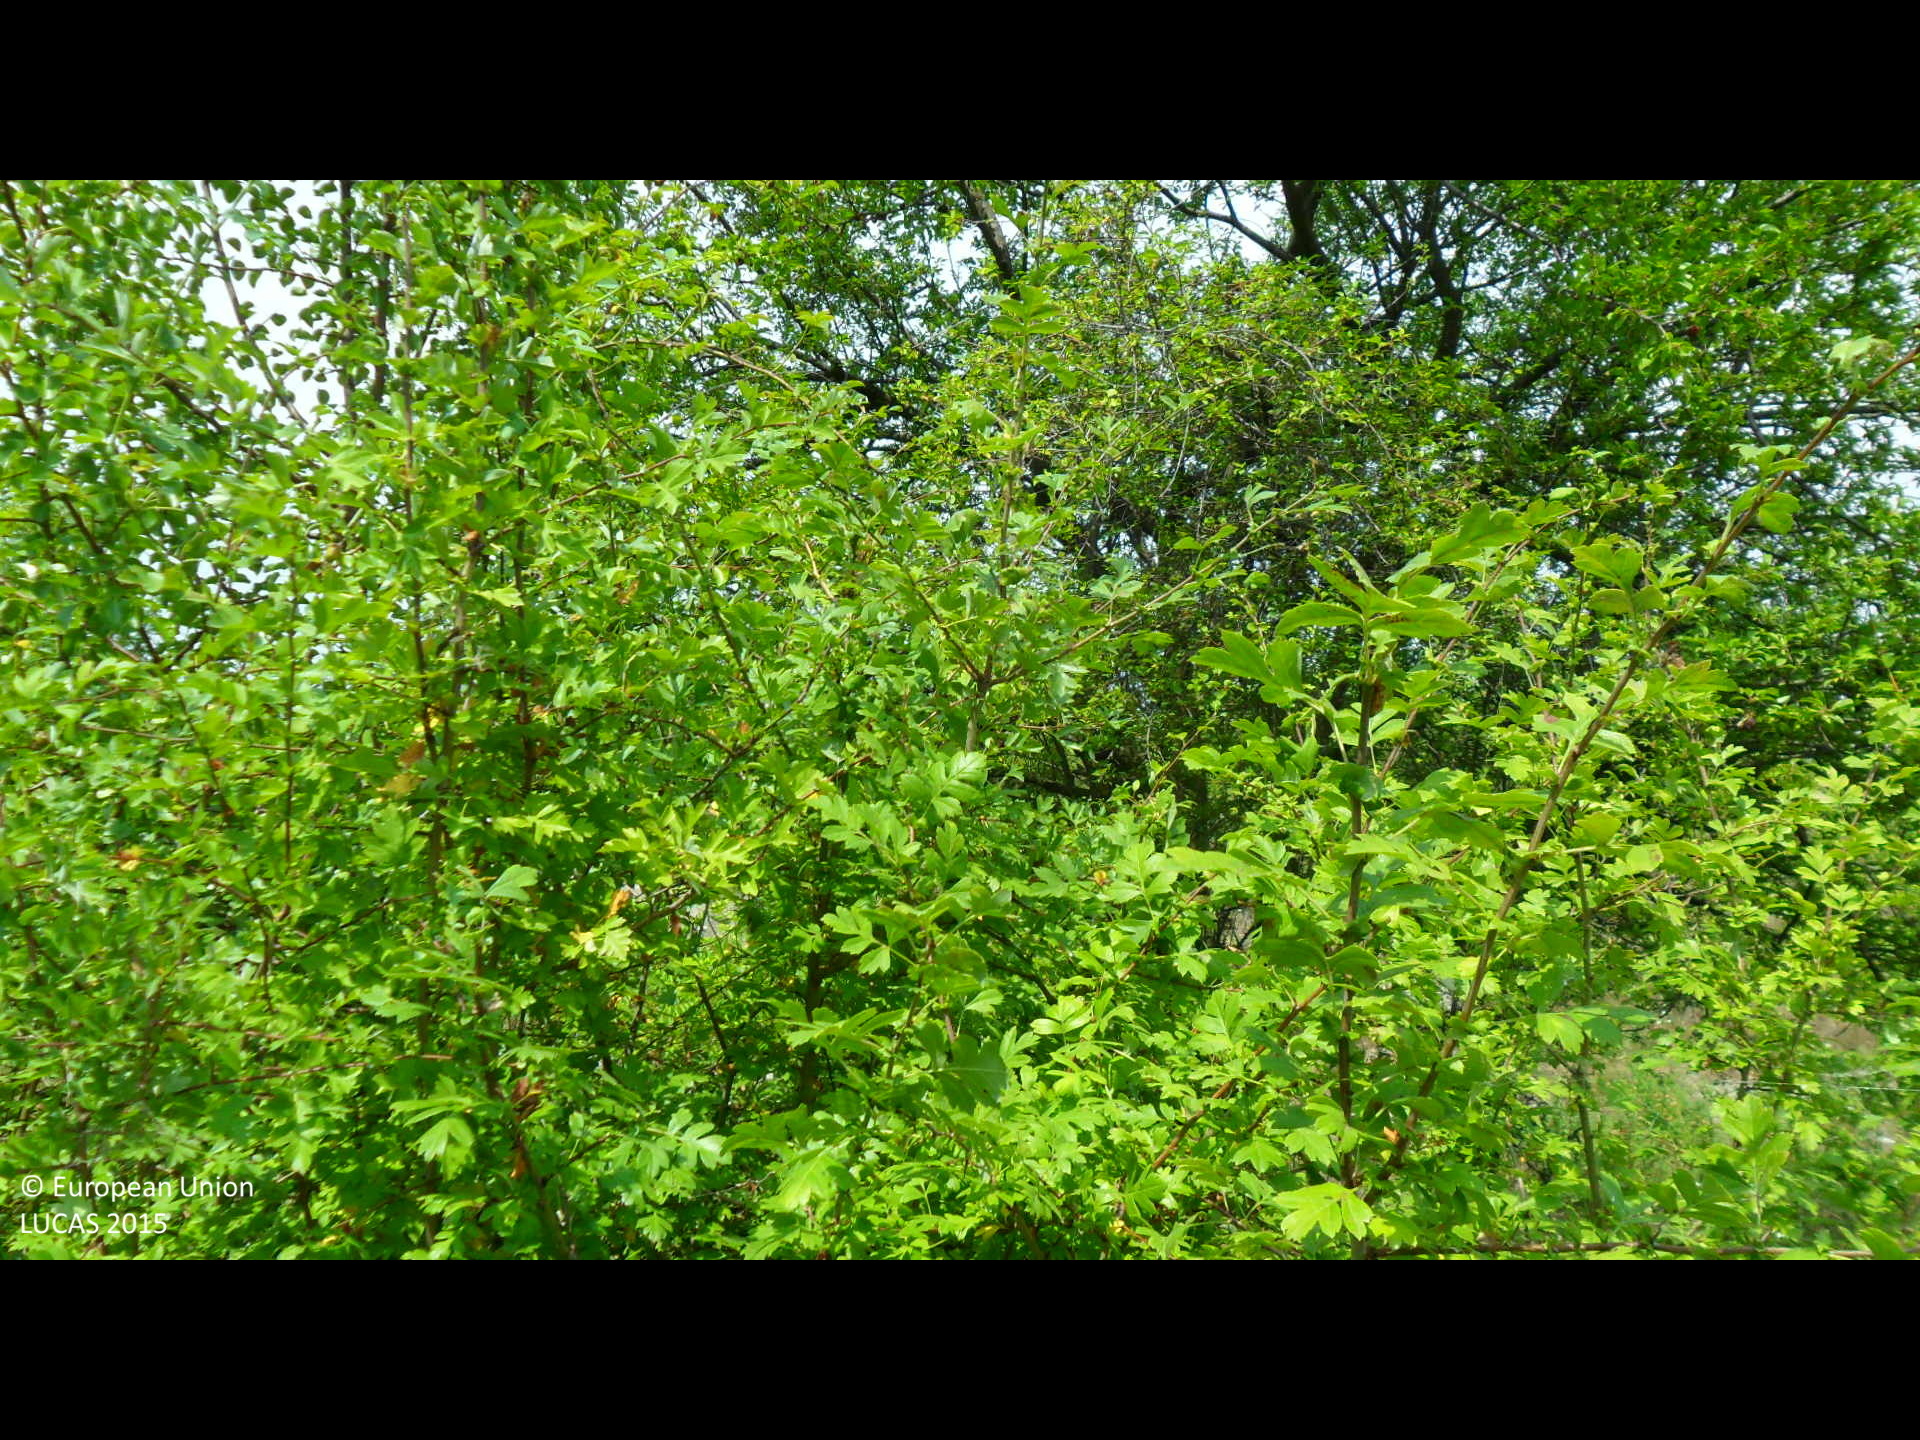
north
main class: Woodland
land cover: Broadleaved woodland
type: mesophytic deciduous forest
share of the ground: > 75 %
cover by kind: broadleaved forest trees 90 %, shrubs 10 %
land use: Forestry
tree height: > 5 m
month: July
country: BG
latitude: 43.3596
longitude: 26.3244
